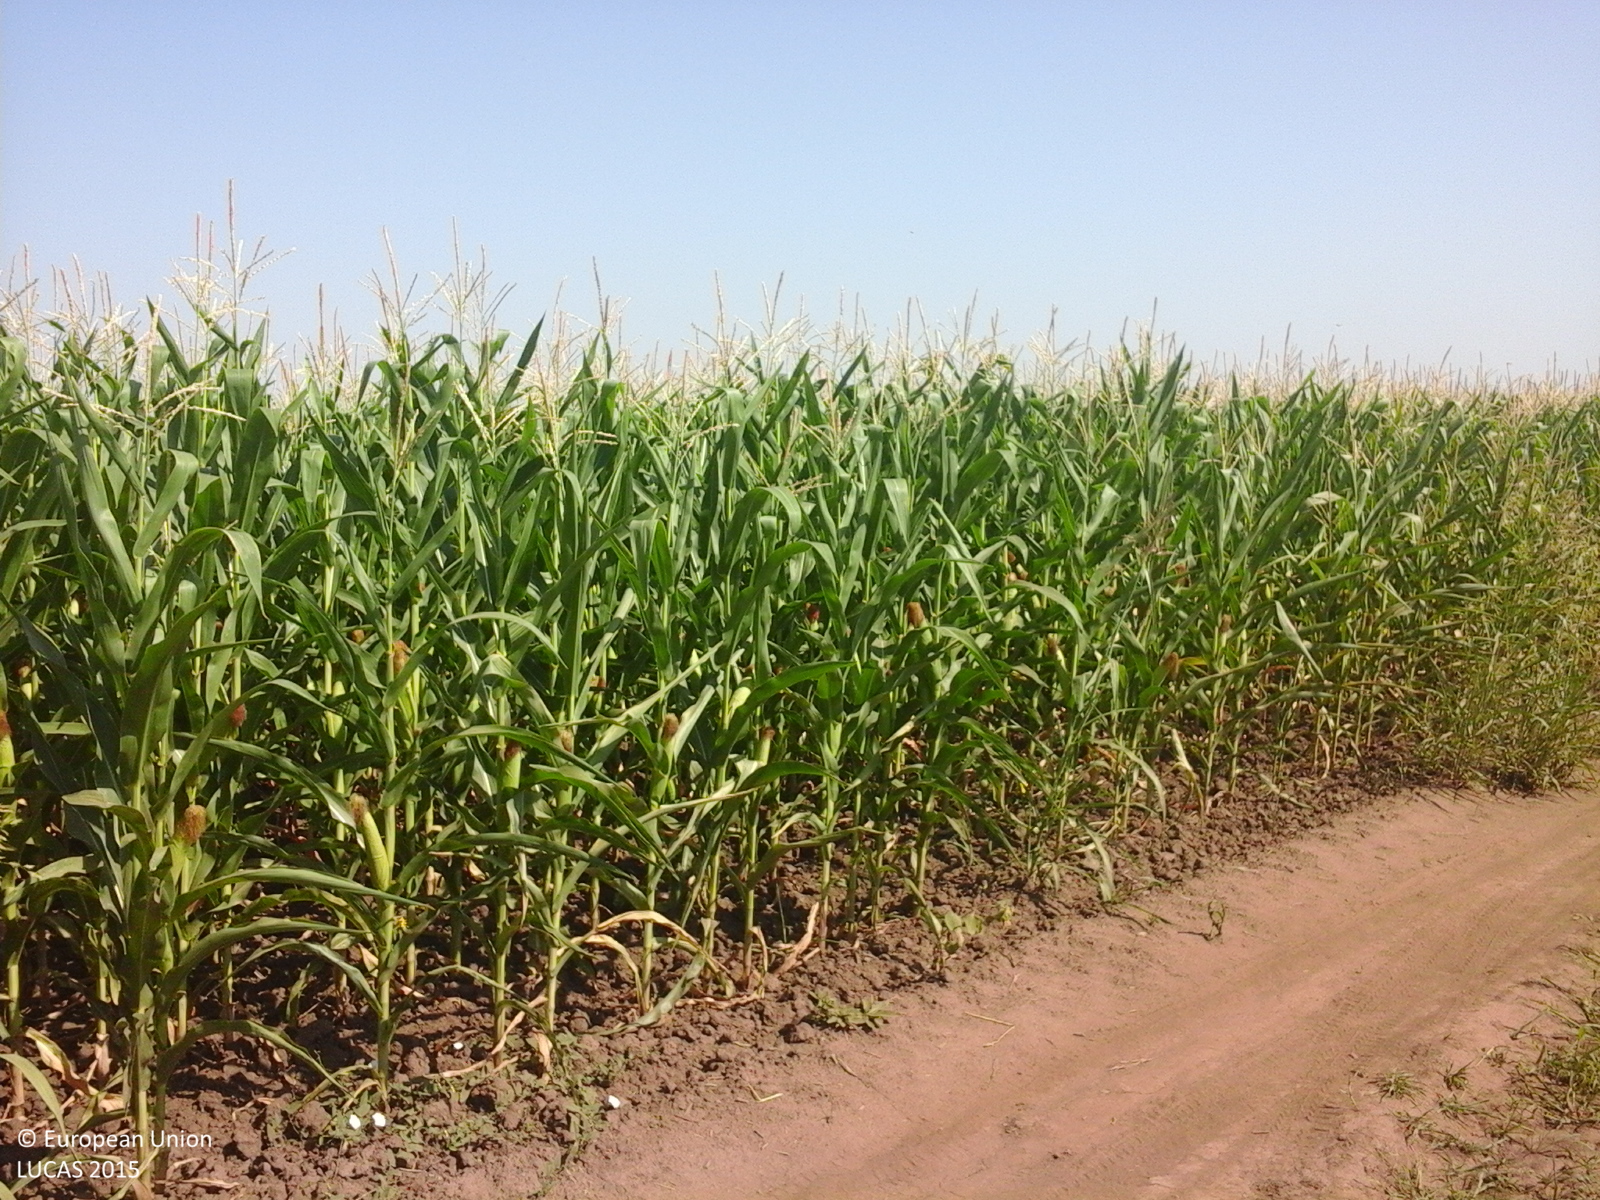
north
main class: Cropland
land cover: Maize
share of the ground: > 75 %
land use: Agriculture (excluding fallow land and kitchen gardens)
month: July
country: RO
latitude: 44.8192
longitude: 27.0673
